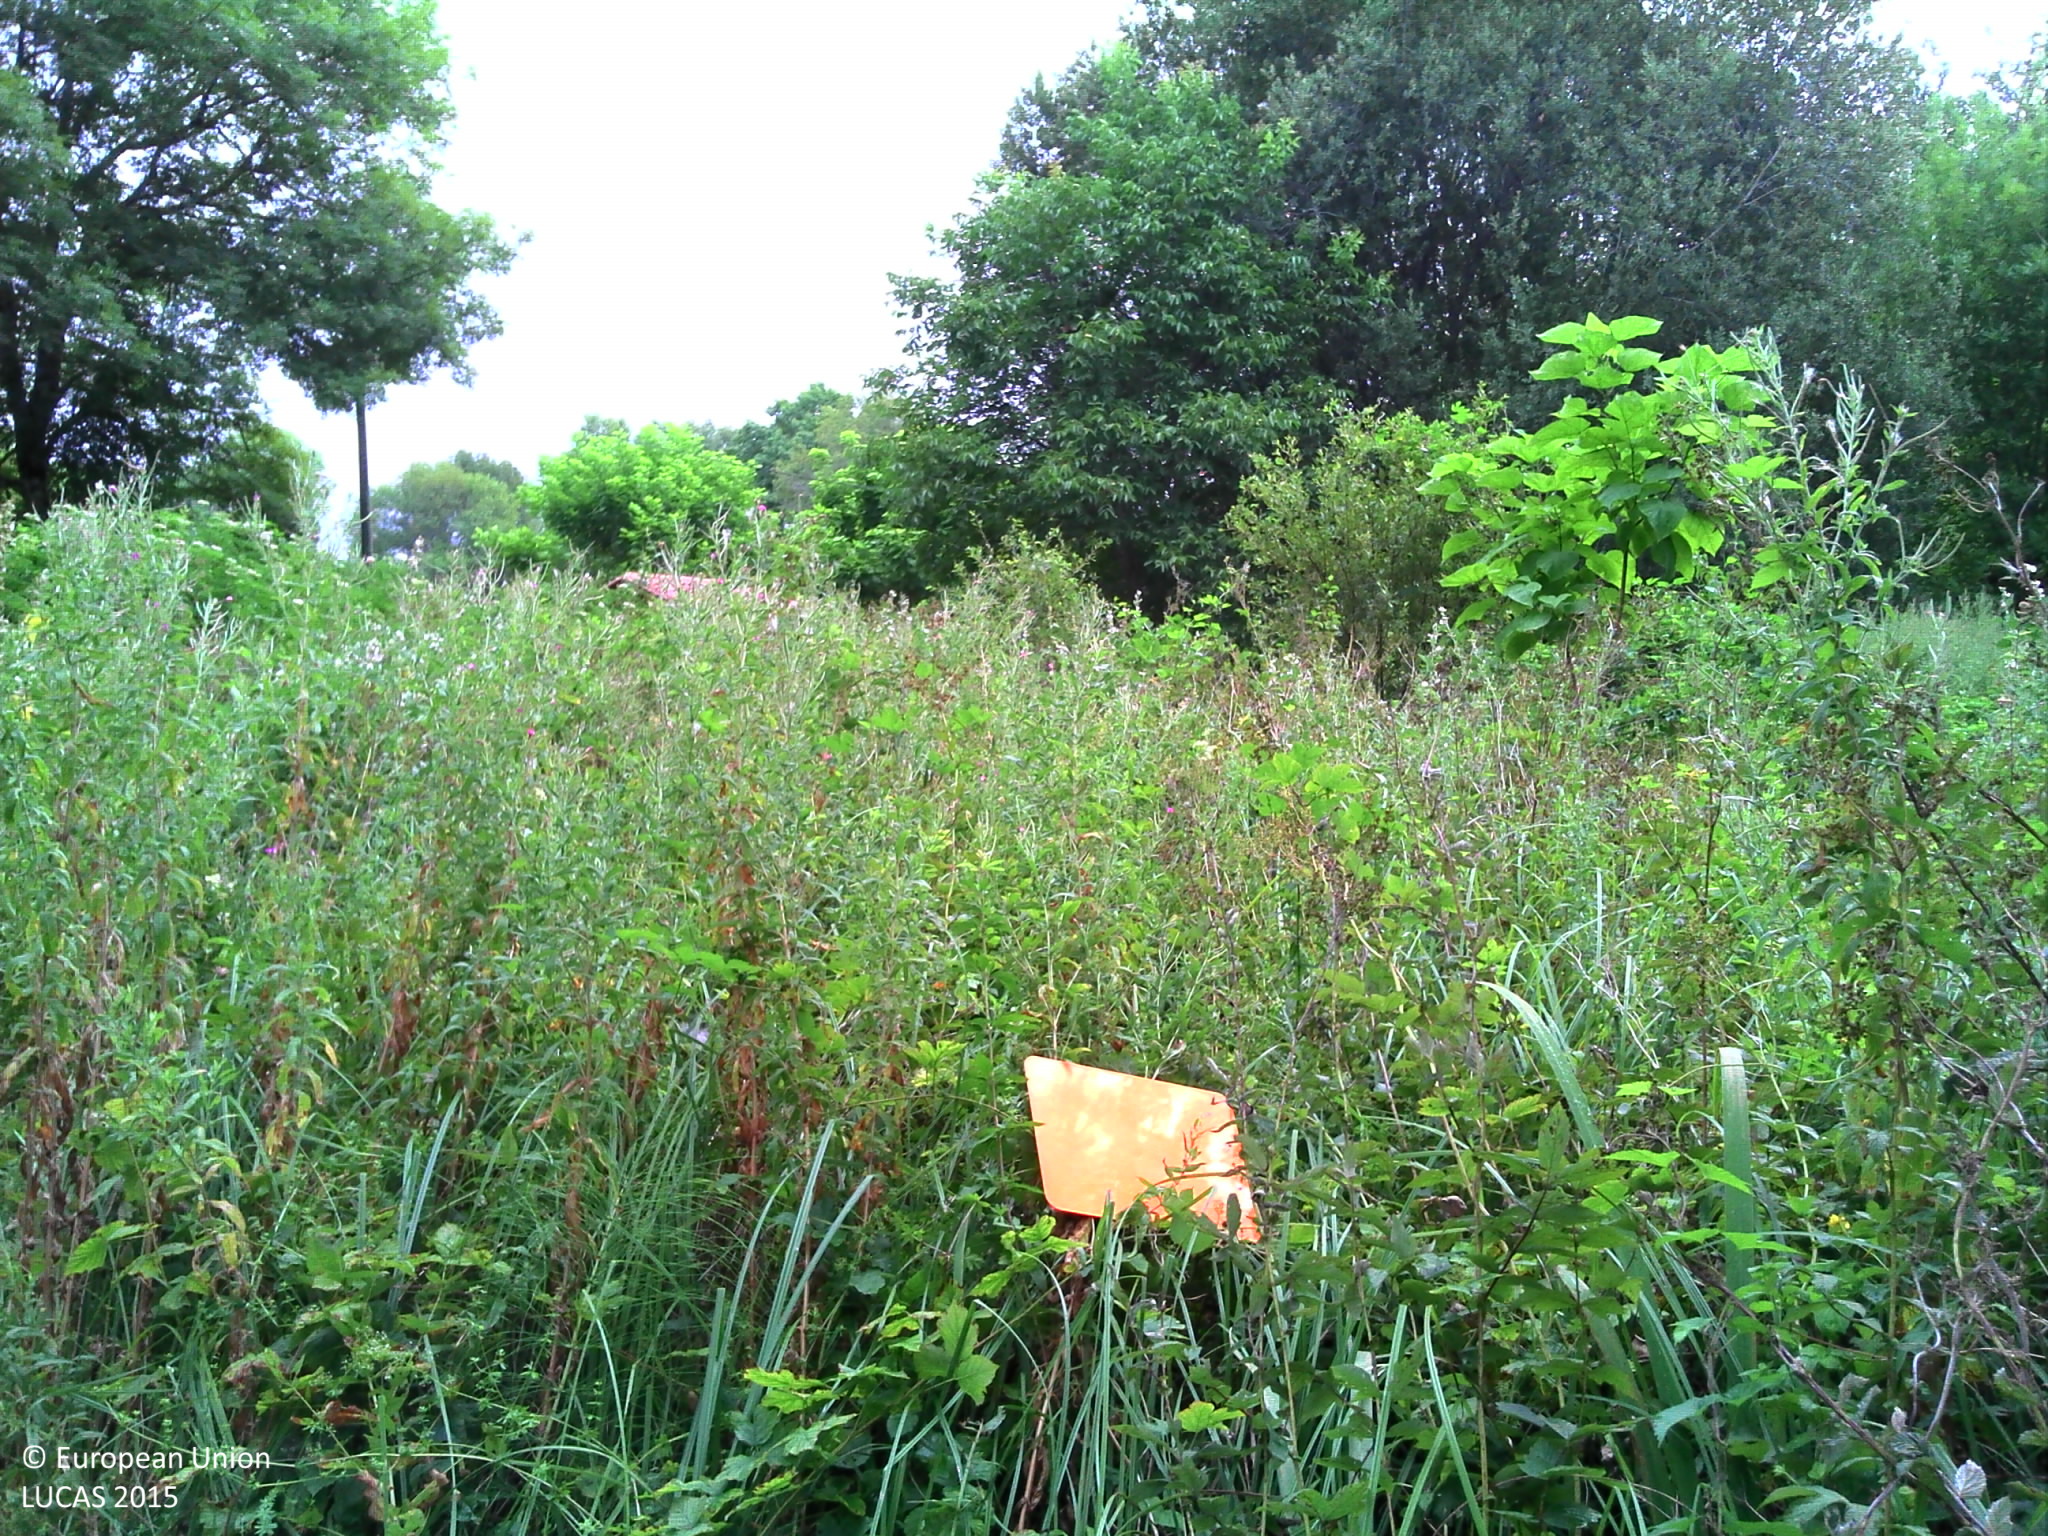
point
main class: Grassland
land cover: Spontaneously vegetated surfaces
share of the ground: > 75 %
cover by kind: herbaceous plants 95 %, shrubs 5 %
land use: Semi-natural and natural areas not in use
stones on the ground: < 10 %
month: July
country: FR
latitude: 44.9369
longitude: 0.7793
